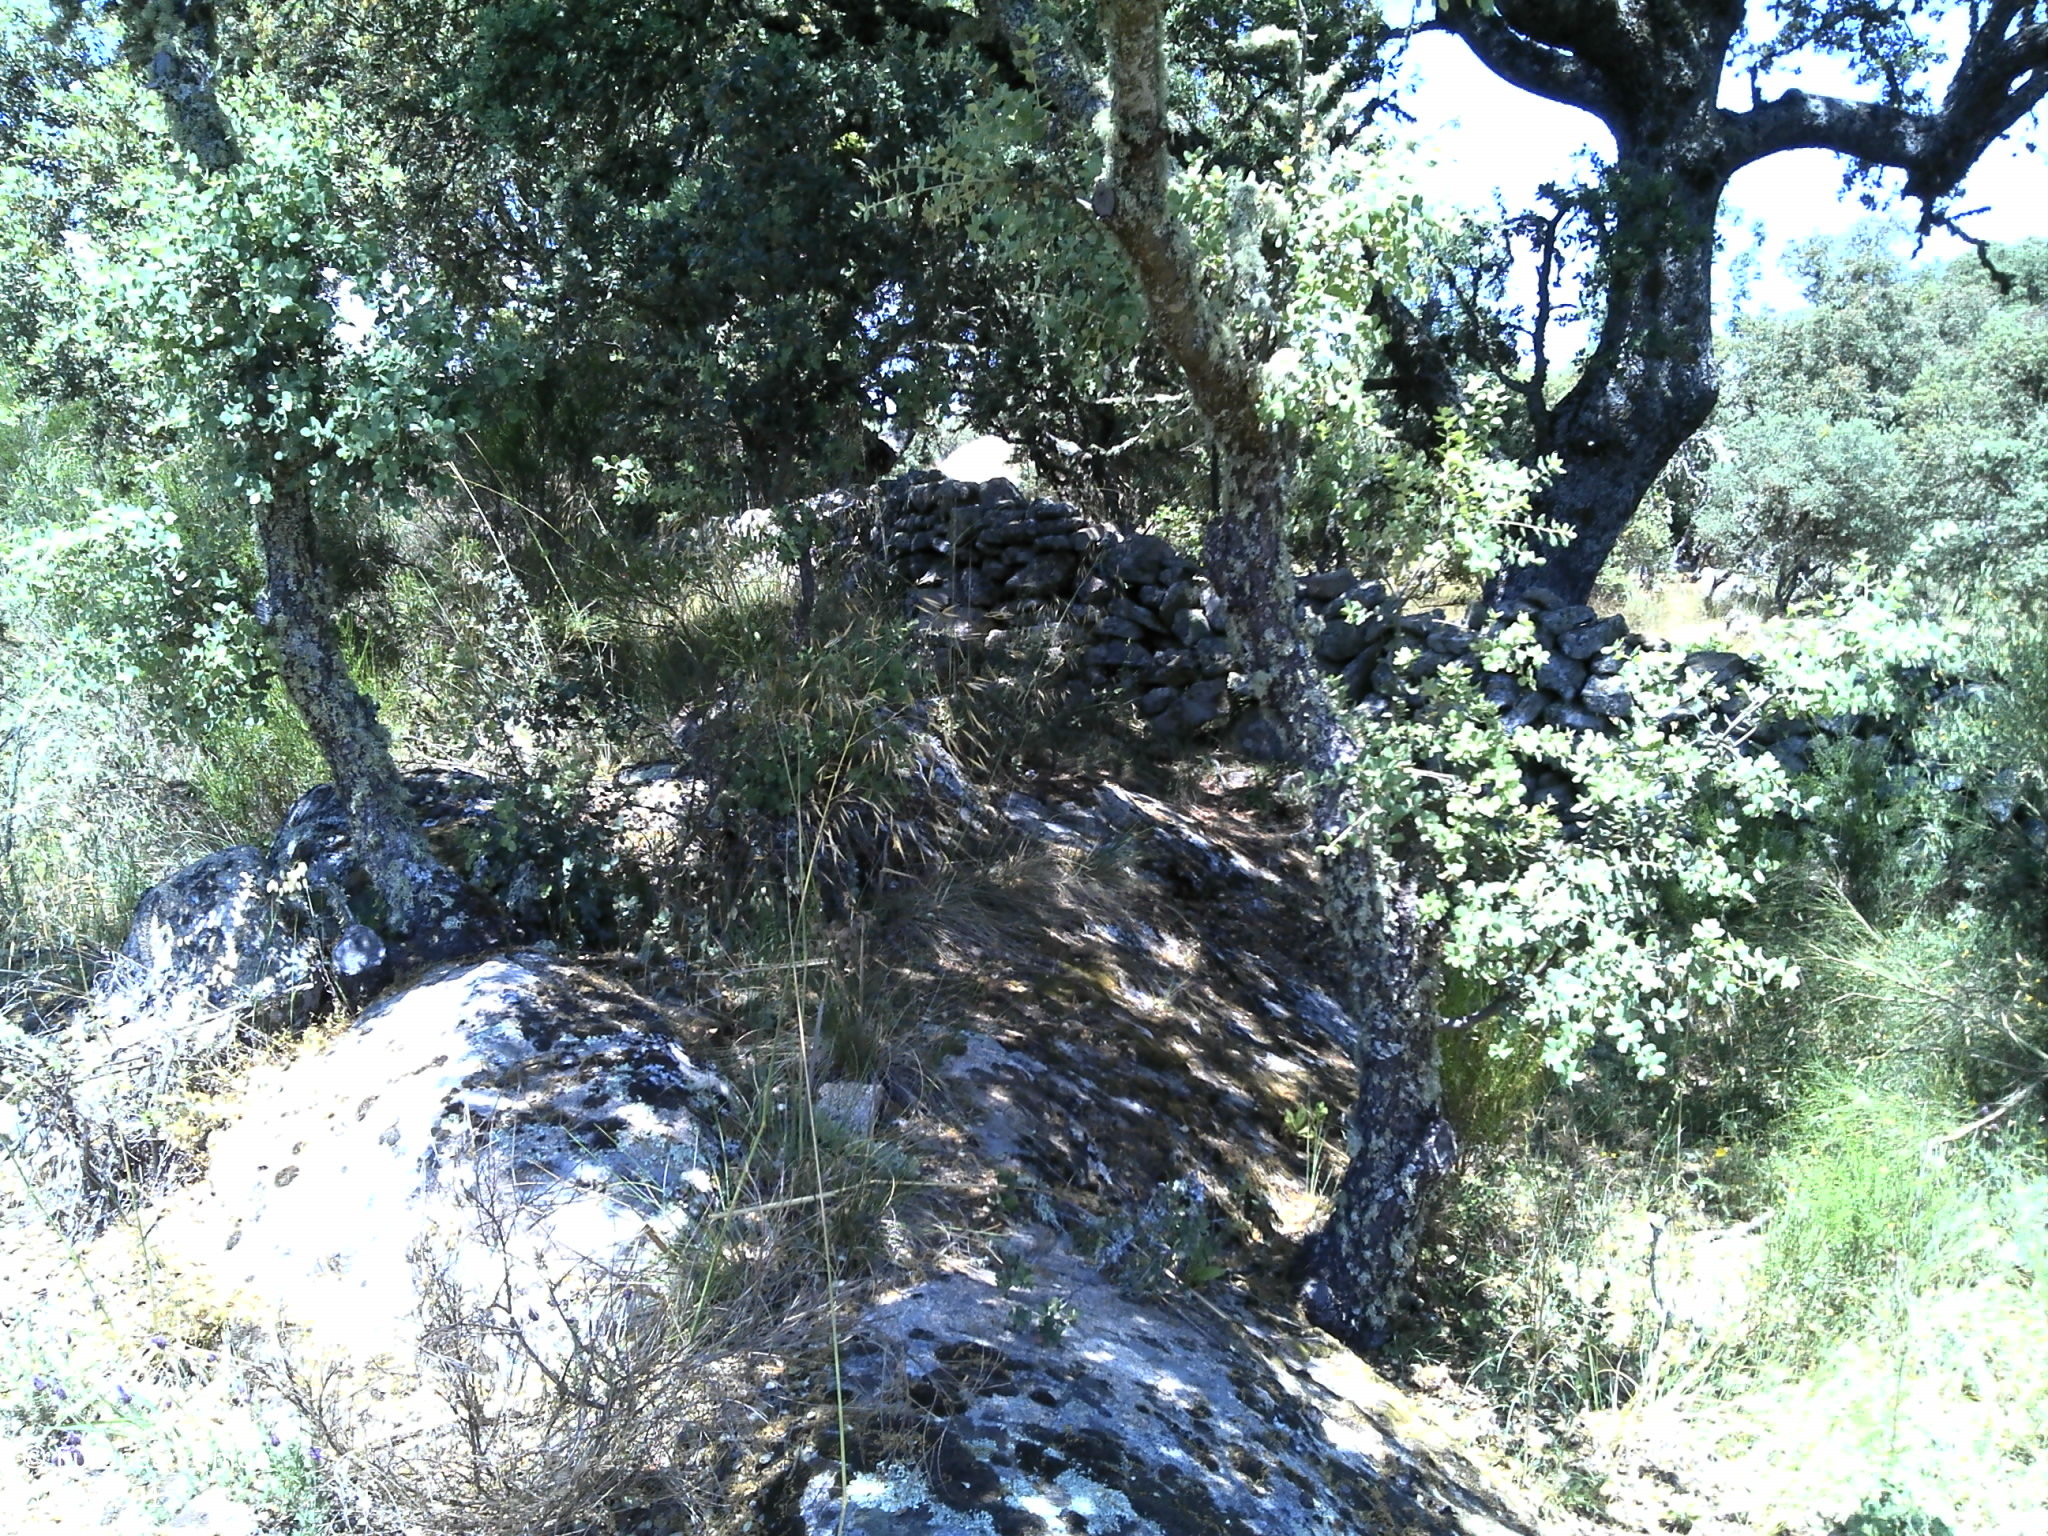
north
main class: Shrubland
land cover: Shrubland with sparse tree cover
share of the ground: > 75 %
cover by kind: shrubs 80 %, herbaceous plants 10 %, broadleaved forest trees 5 %, unconsolidated bare surface 5 %
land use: Semi-natural and natural areas not in use
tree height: < 5 m
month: May
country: PT
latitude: 41.5663
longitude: -6.2754
